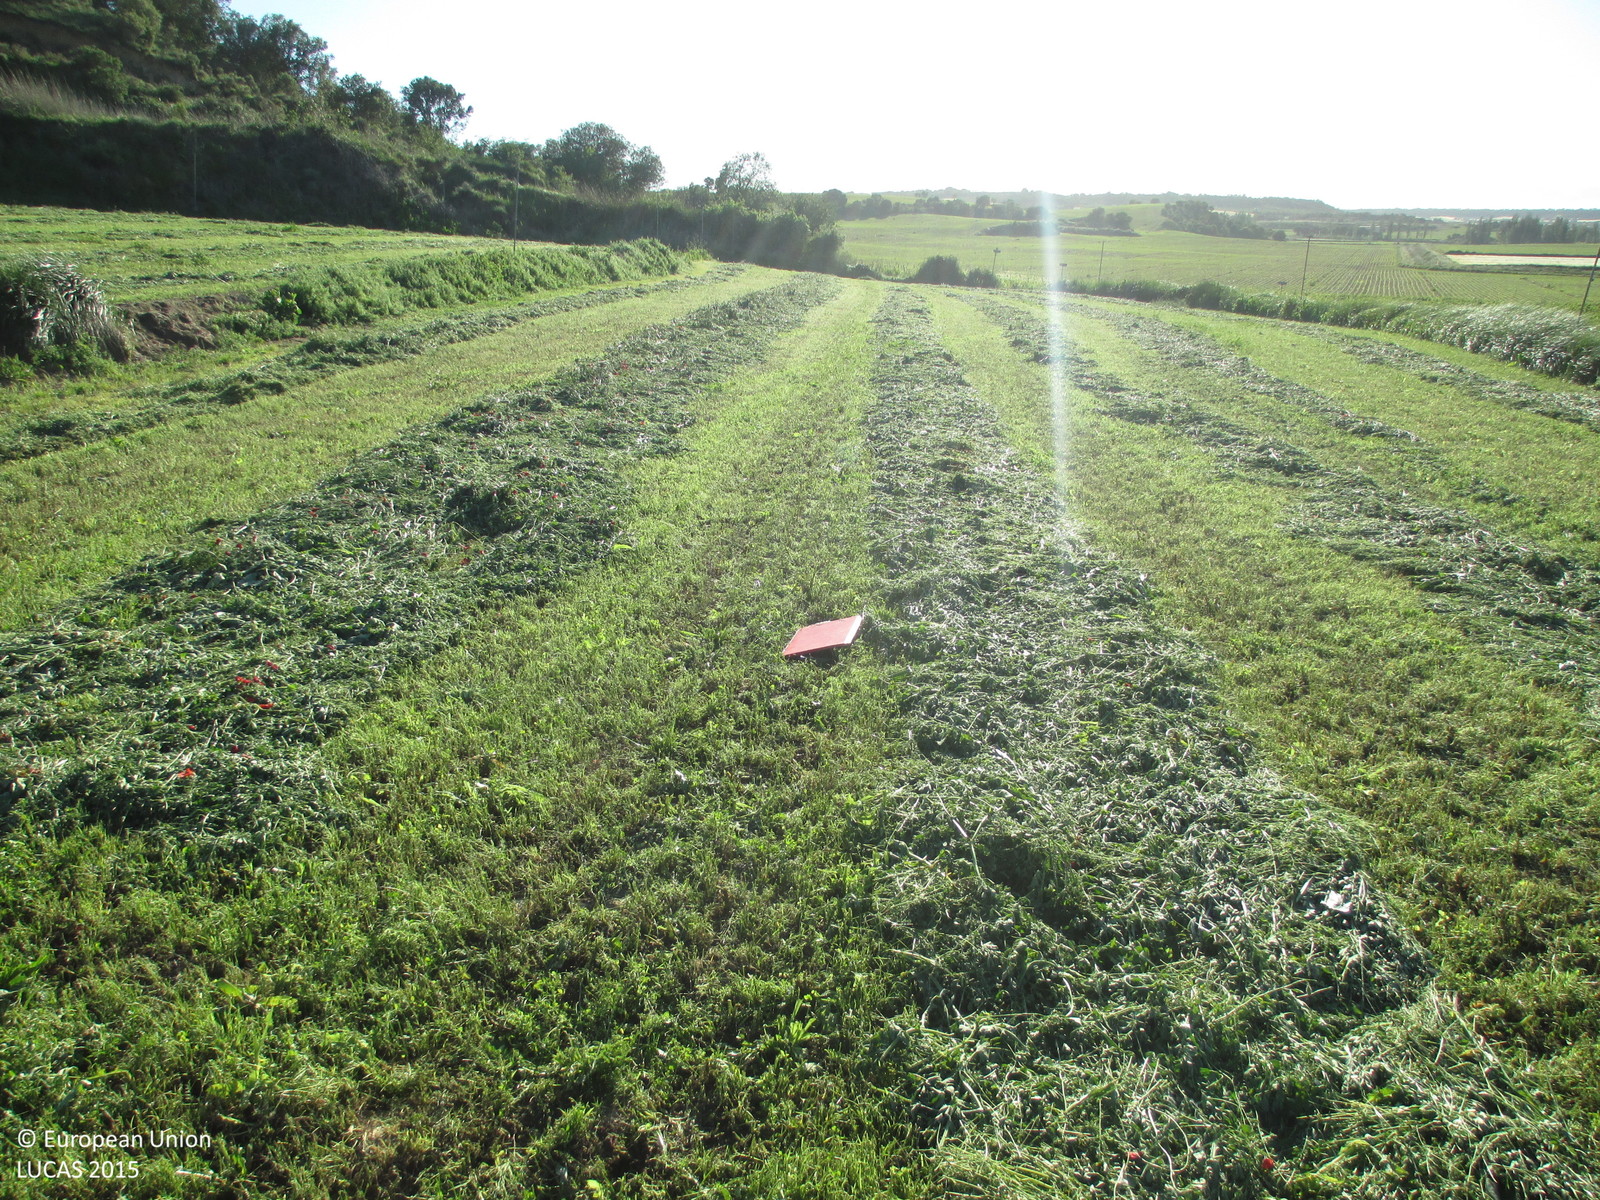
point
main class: Cropland
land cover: Lucerne
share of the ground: > 75 %
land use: Agriculture (excluding fallow land and kitchen gardens)
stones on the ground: < 10 %
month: May
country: ES
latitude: 42.0120
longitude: -0.0049
